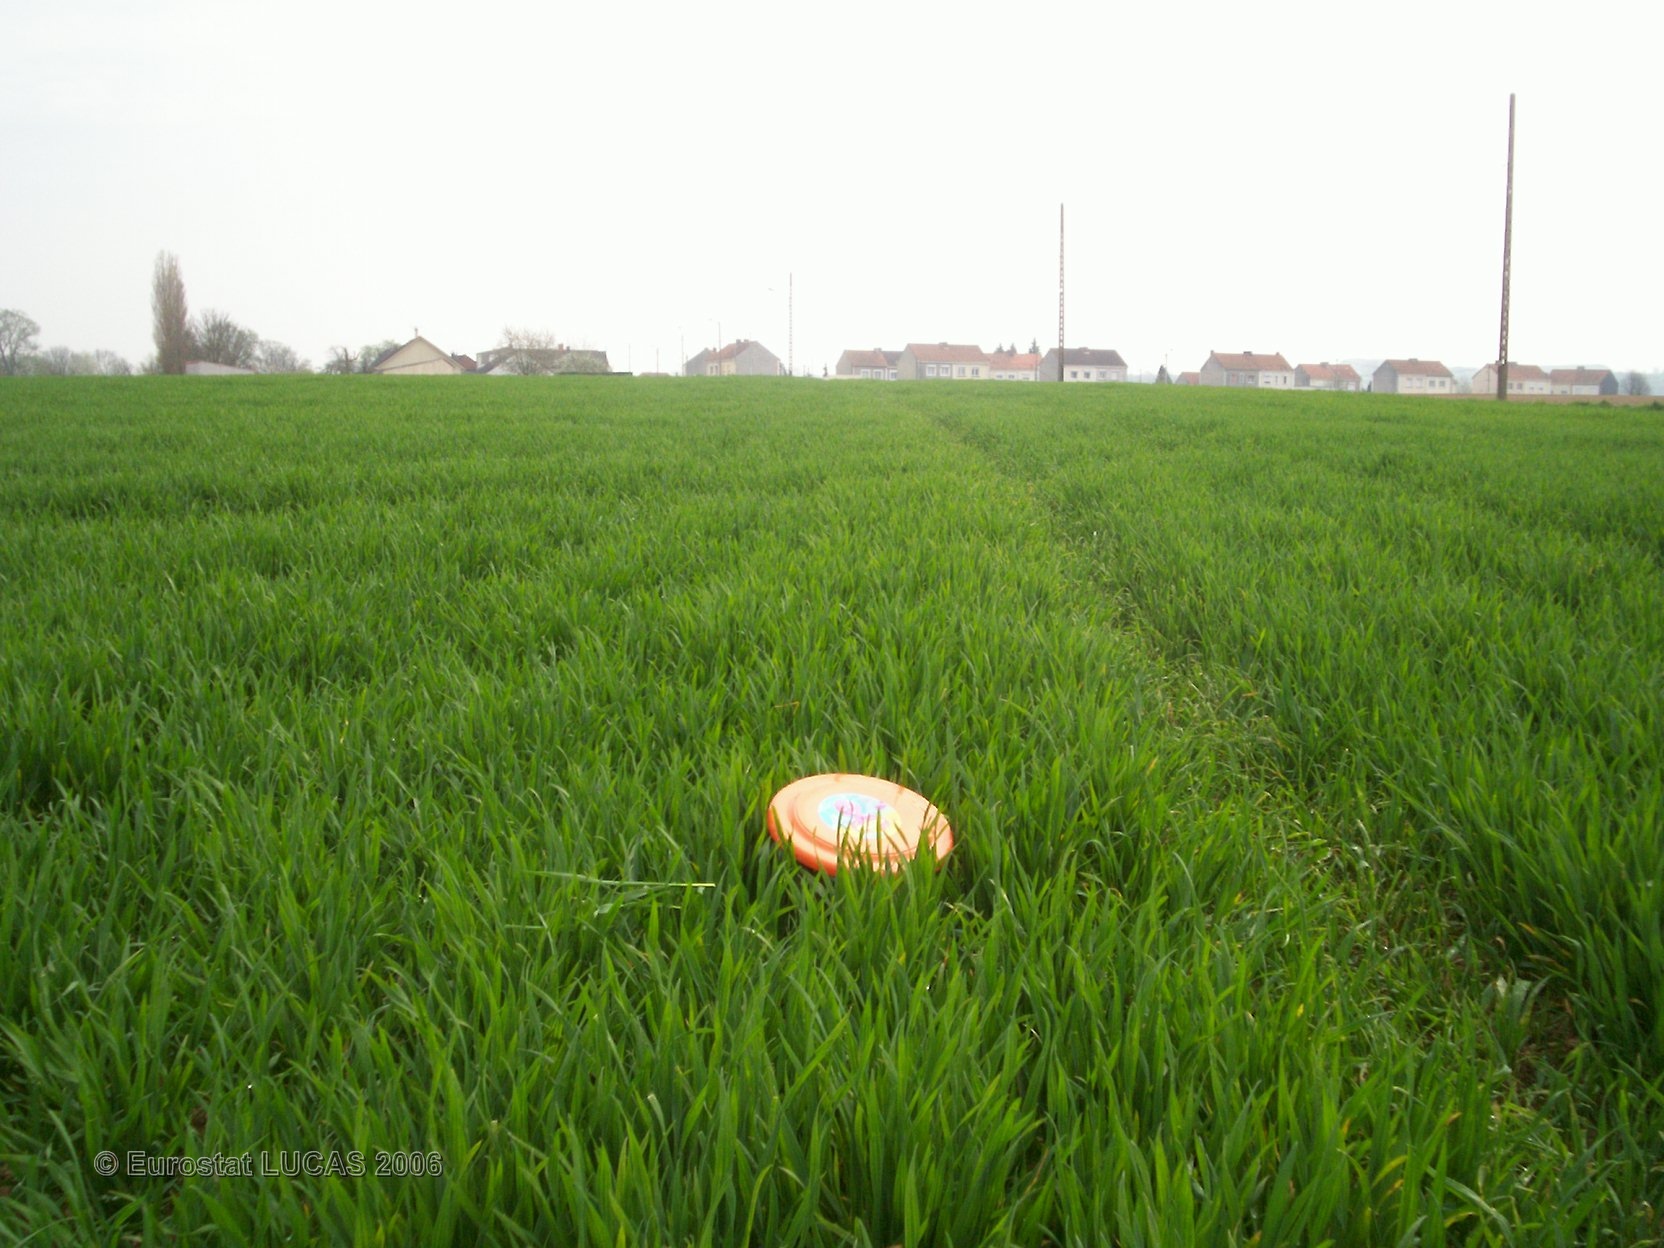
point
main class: Cropland
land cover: Common wheat
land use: Agriculture (excluding fallow land and kitchen gardens)
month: April
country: FR
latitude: 50.5328
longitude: 2.4959
